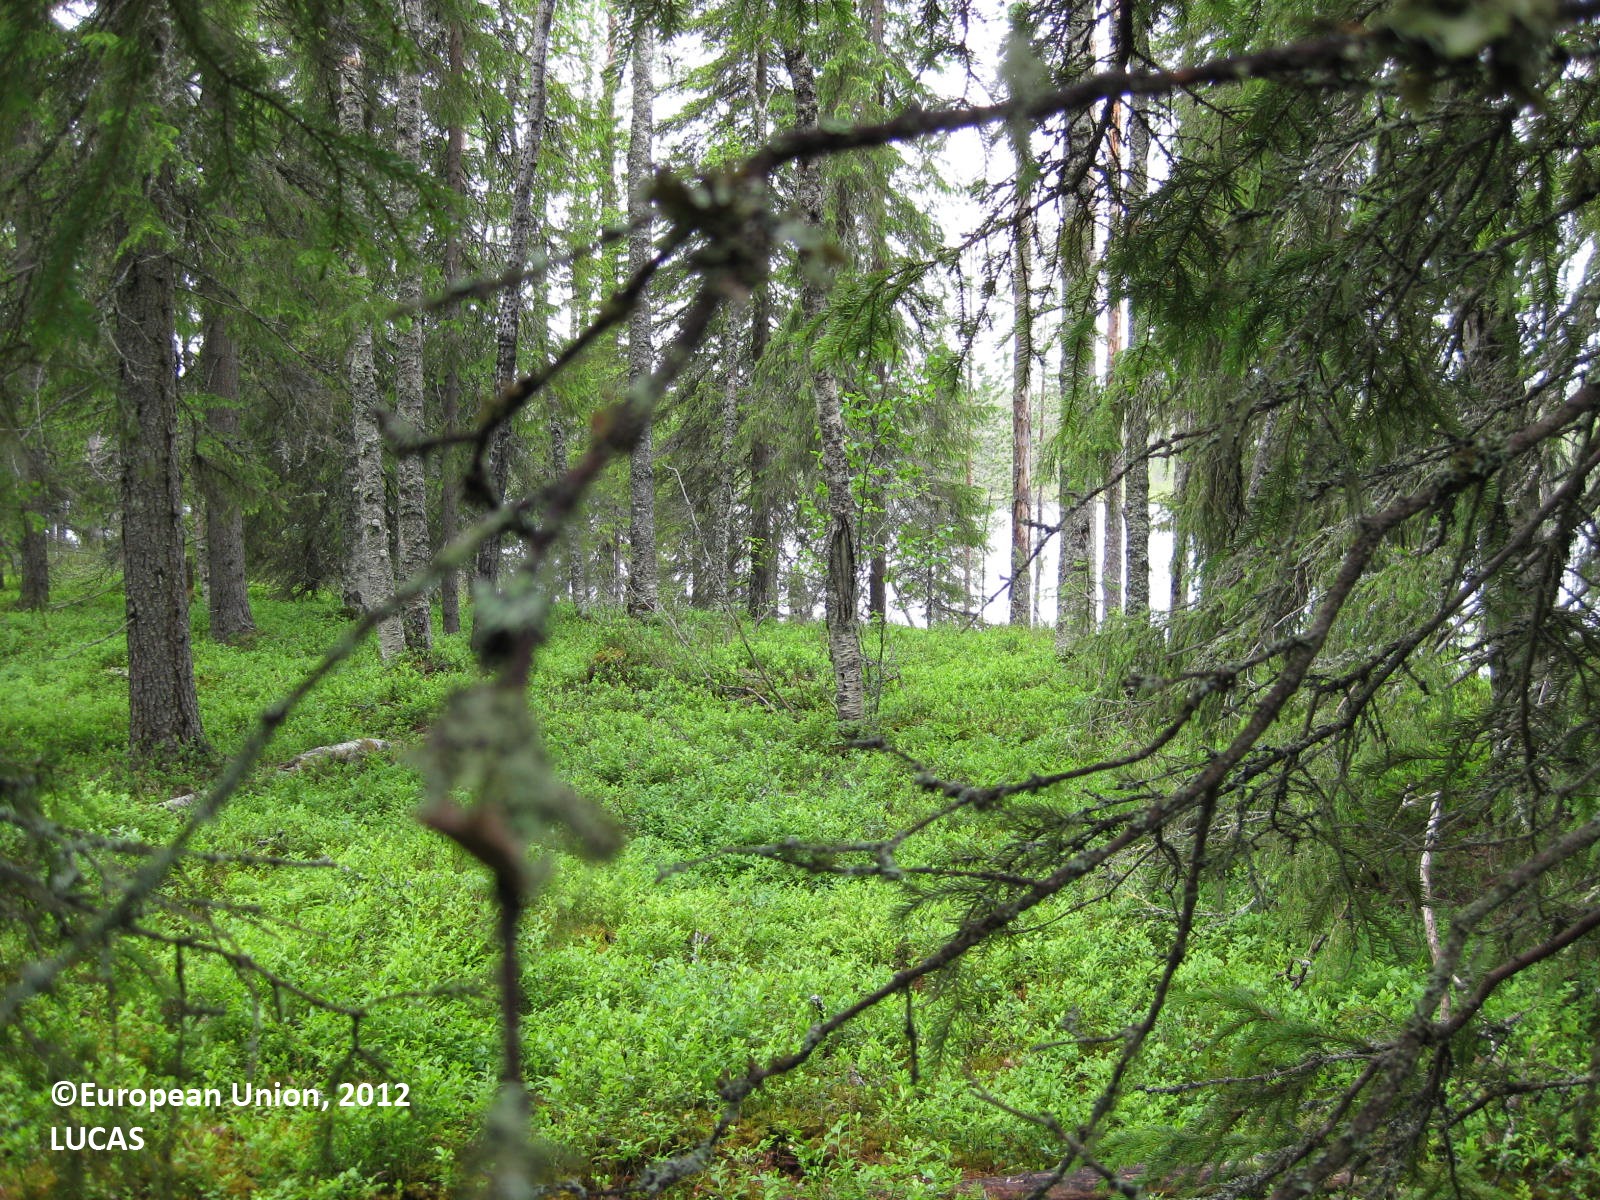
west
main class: Woodland
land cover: Spruce dominated mixed woodland
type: boreal forest
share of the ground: > 75 %
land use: Forestry
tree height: > 5 m
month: July
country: FI
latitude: 65.4657
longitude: 28.3067
